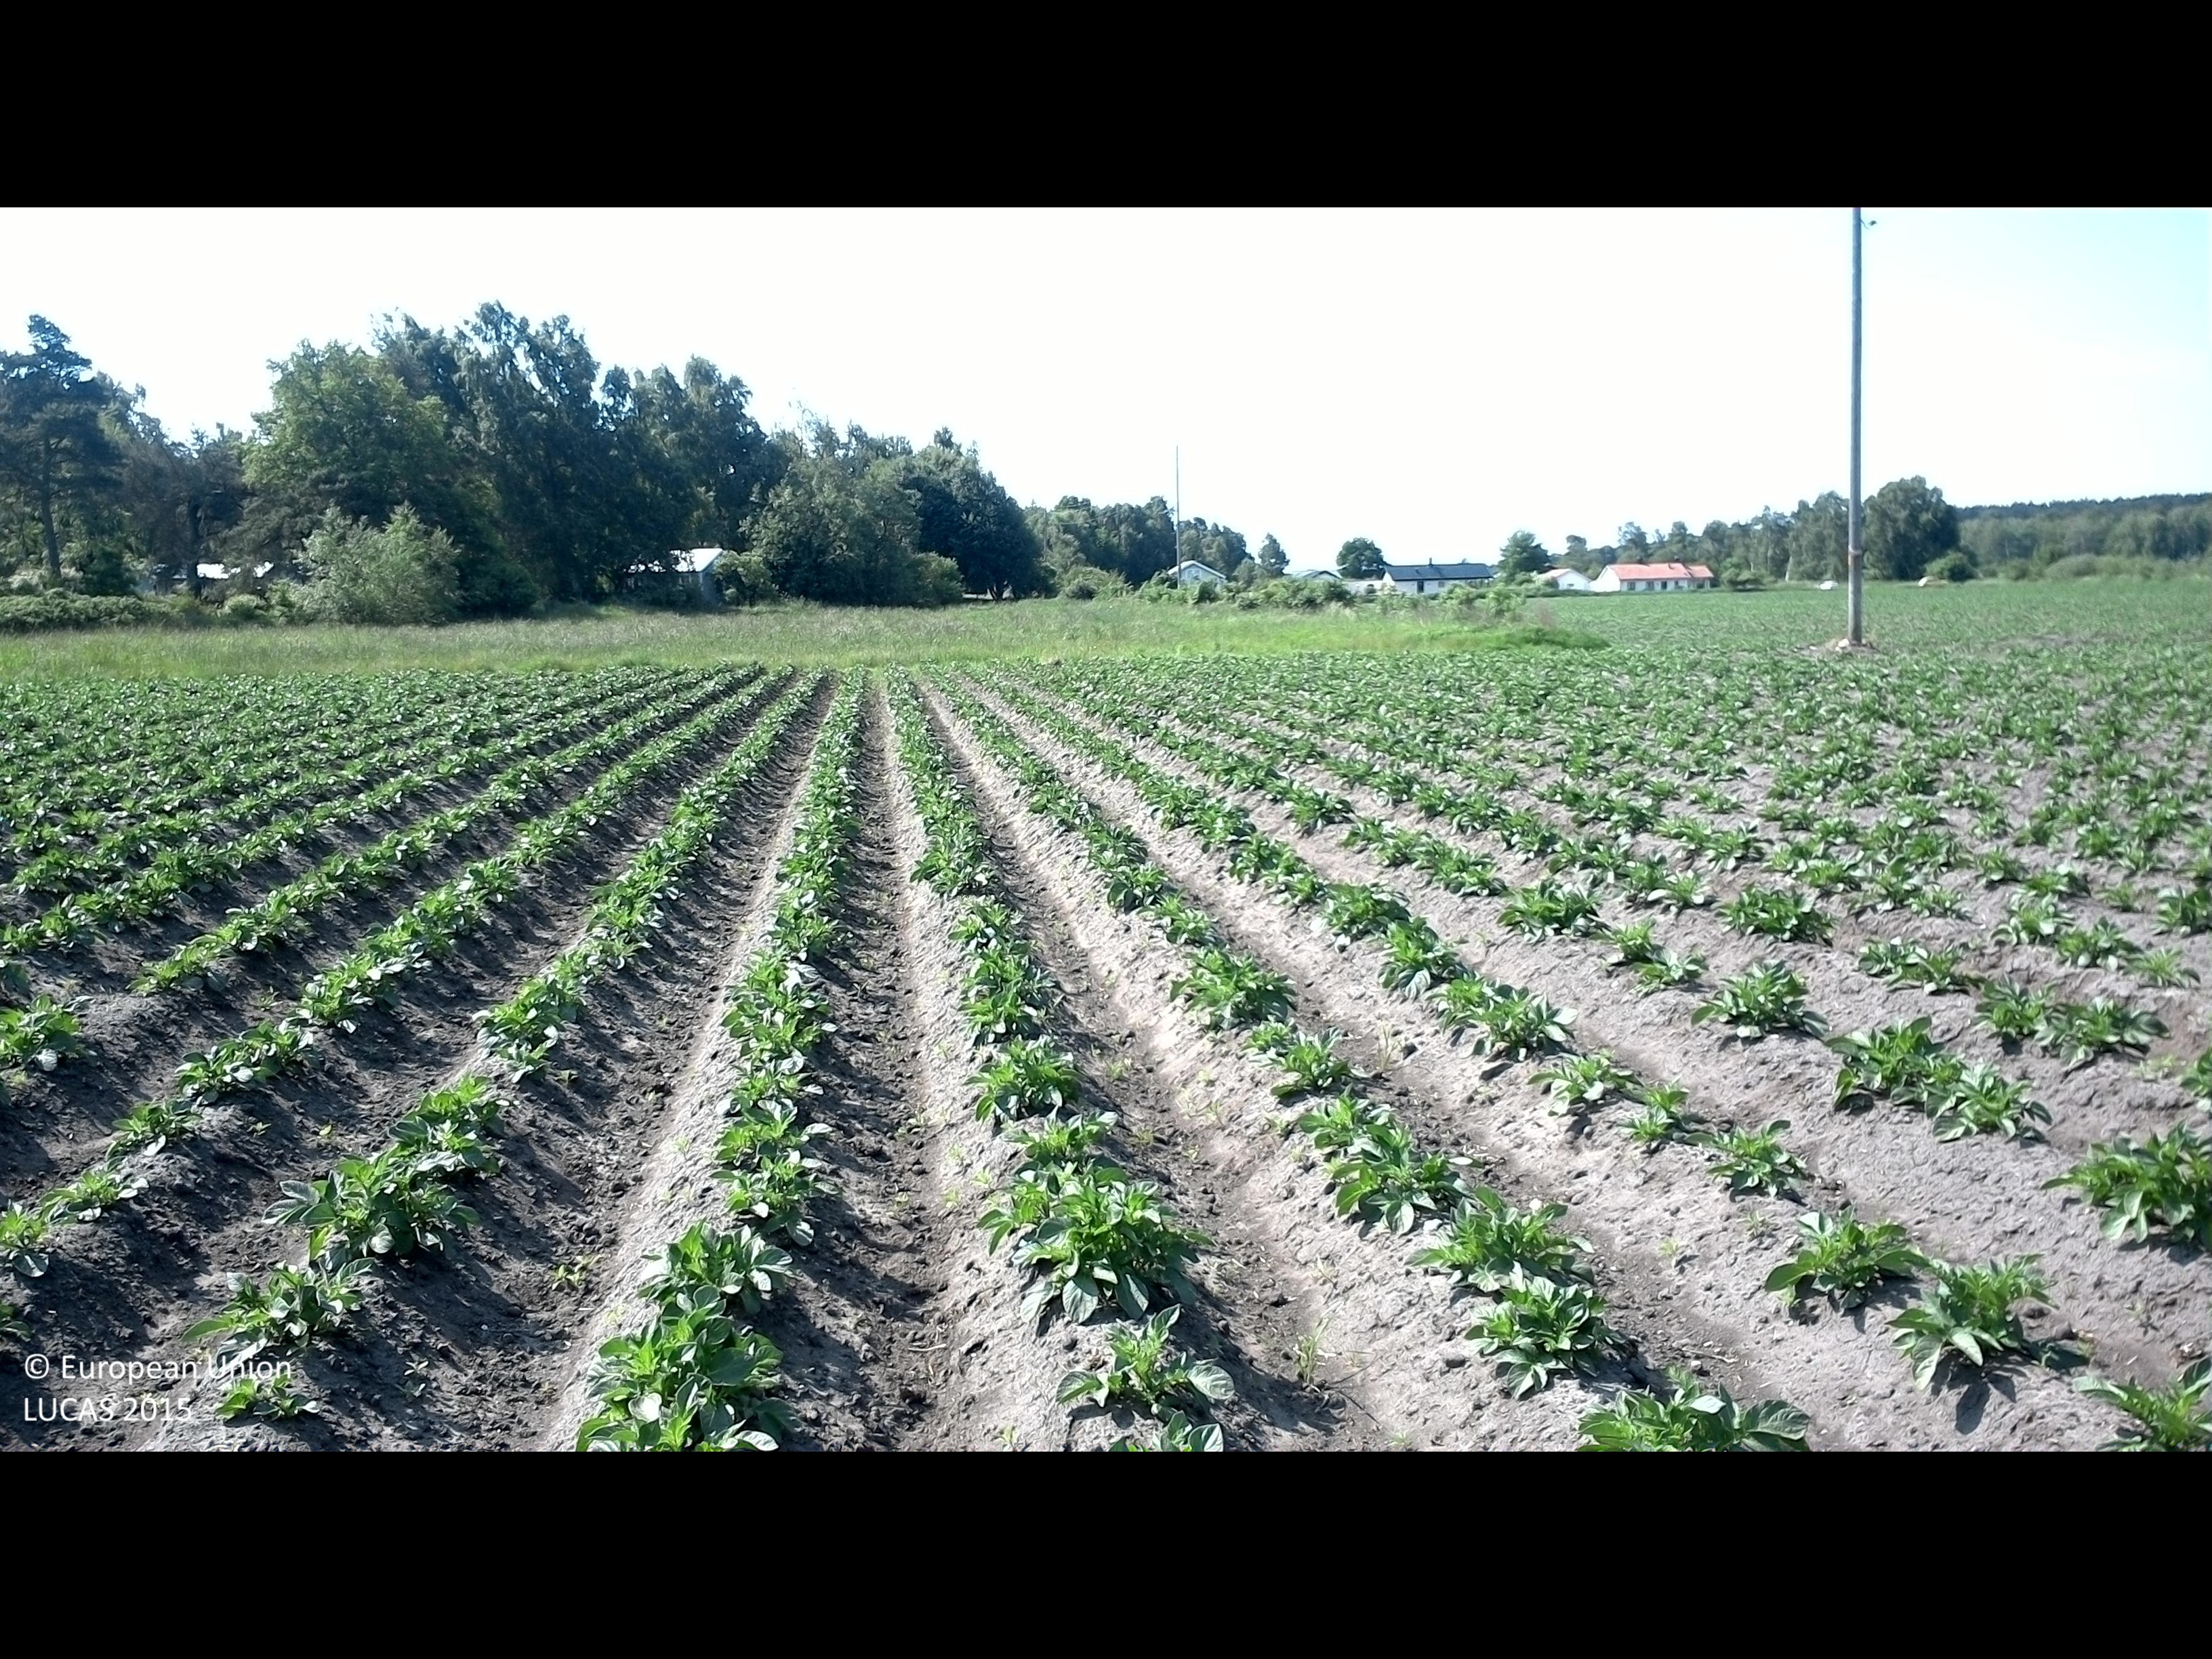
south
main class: Cropland
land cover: Potatoes
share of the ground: 50 - 75 %
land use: Agriculture (excluding fallow land and kitchen gardens)
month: June
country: SE
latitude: 55.7953
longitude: 14.1933
